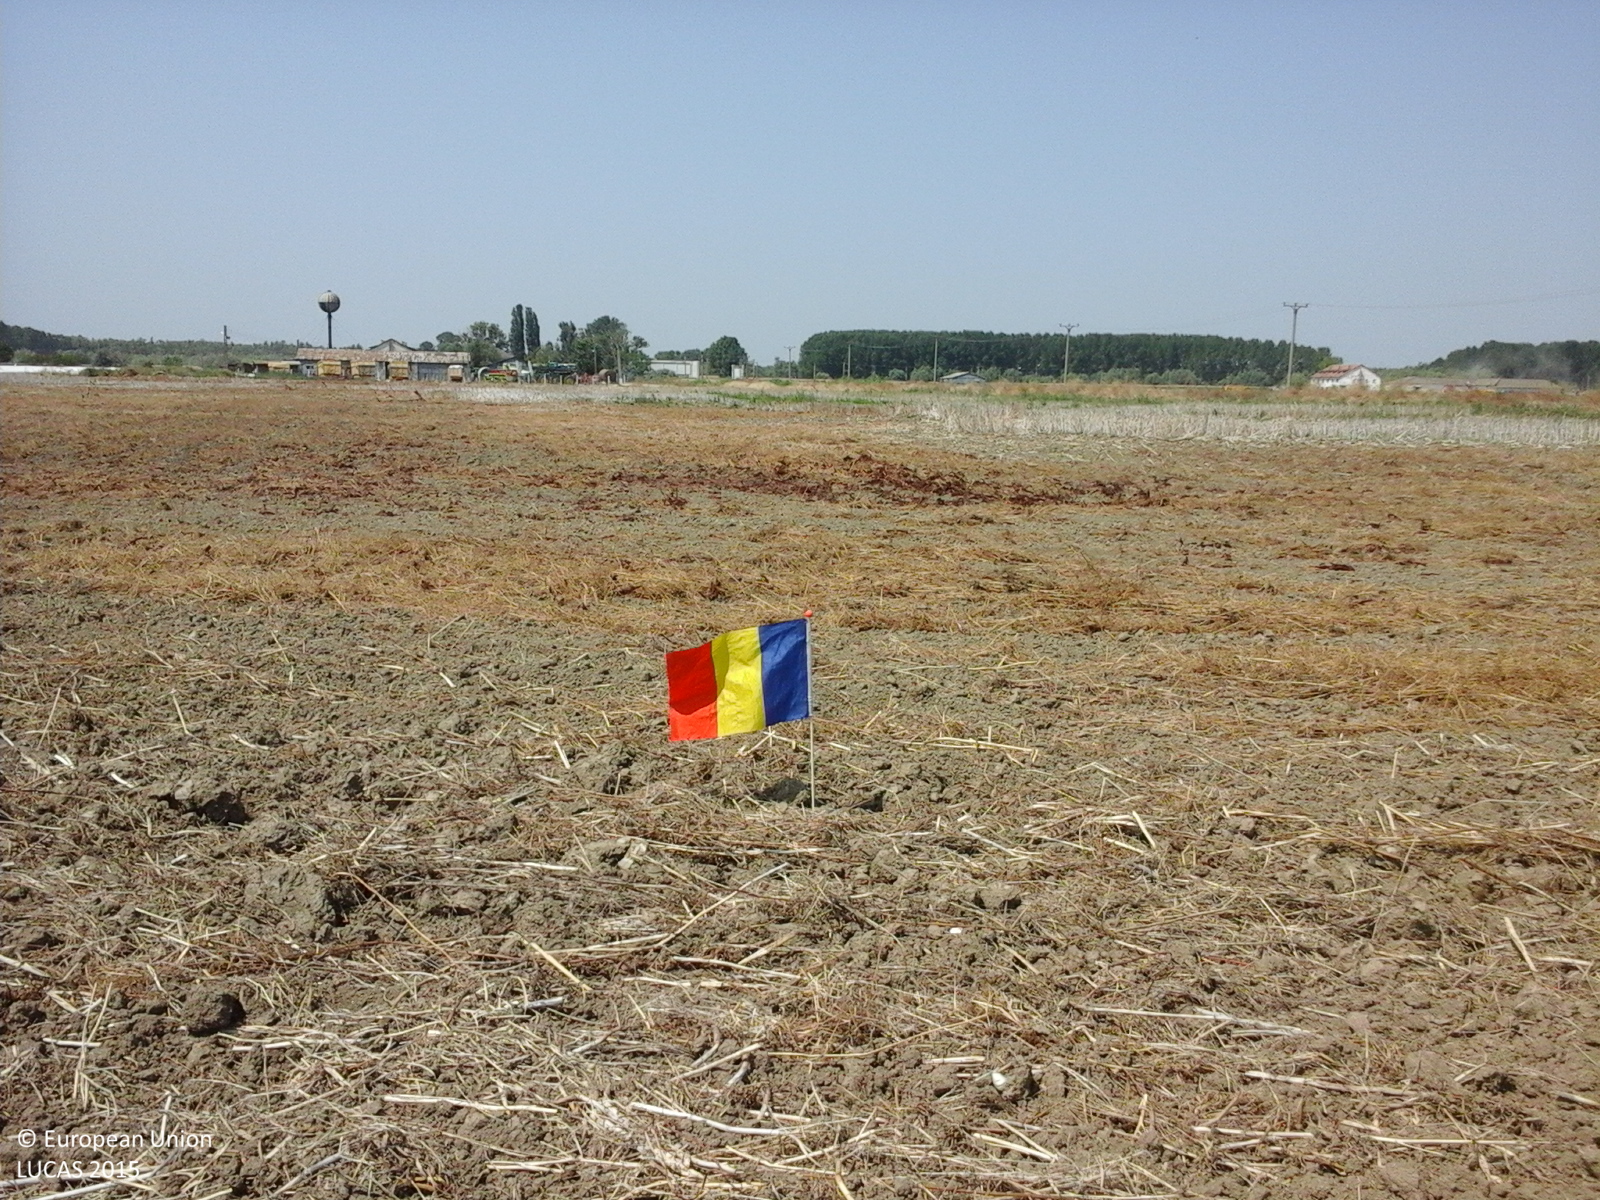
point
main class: Cropland
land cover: Rape and turnip rape
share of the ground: < 10 %
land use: Agriculture (excluding fallow land and kitchen gardens)
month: August
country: RO
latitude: 45.0600
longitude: 27.9280
